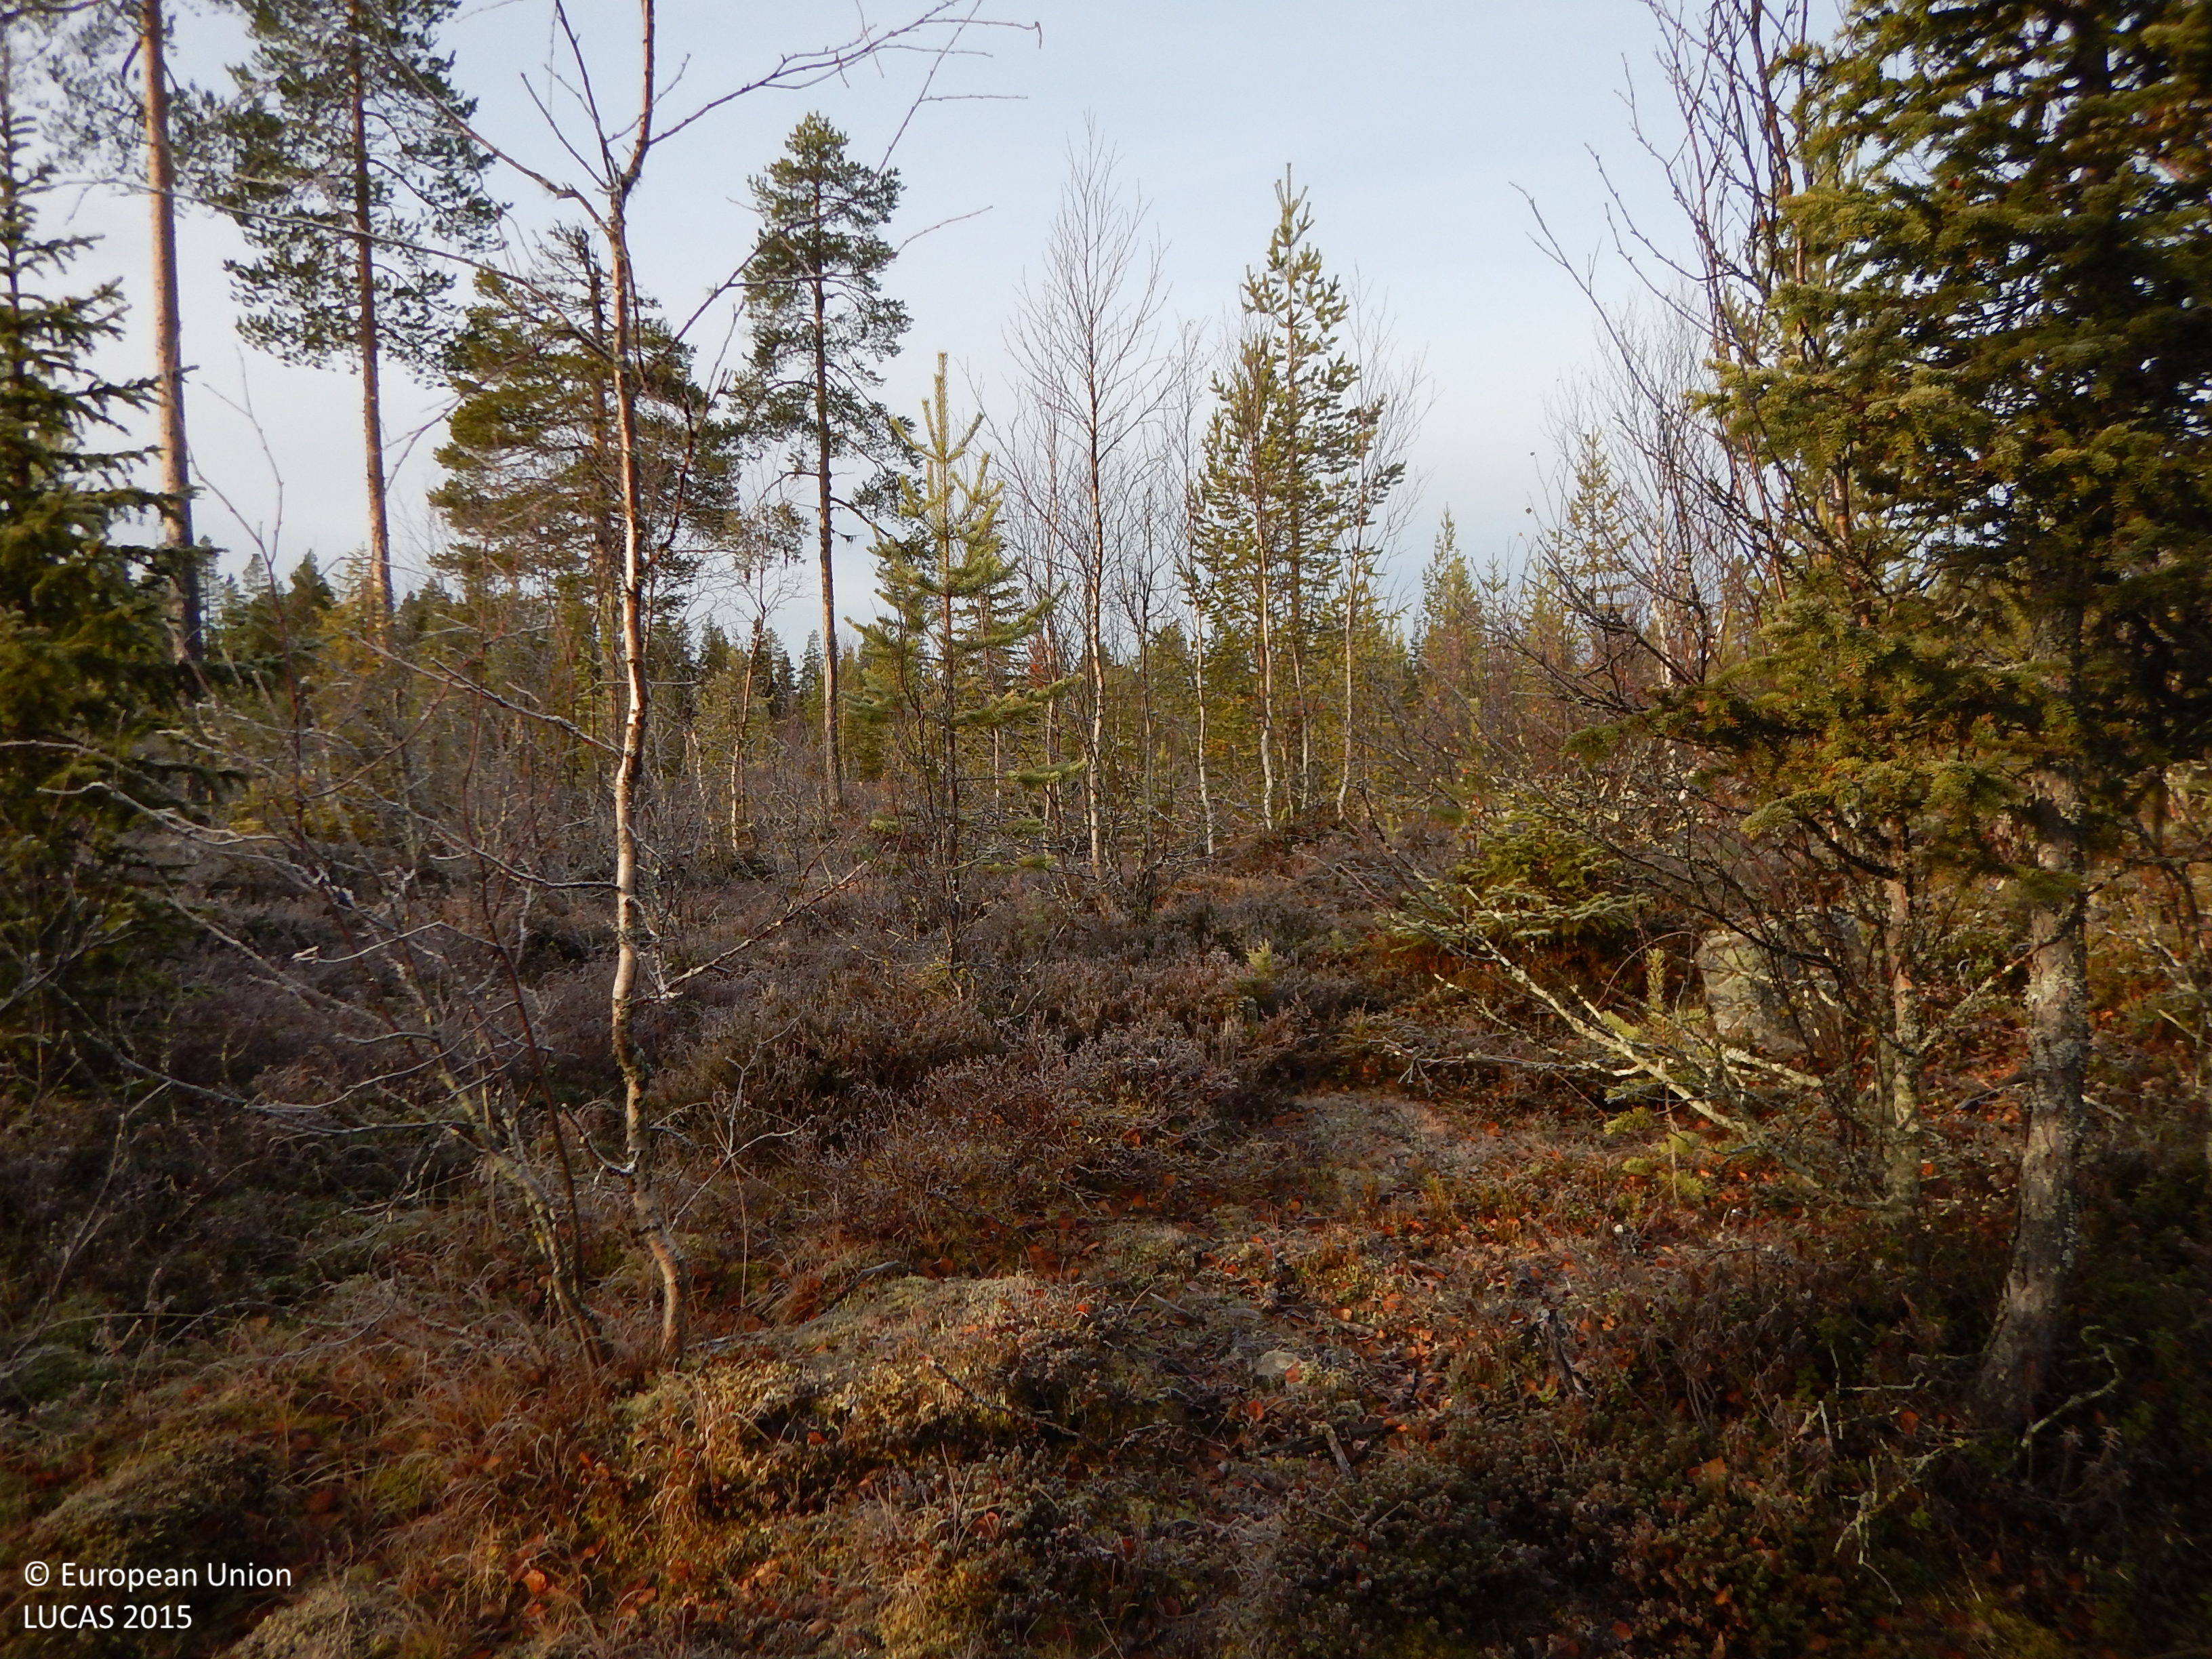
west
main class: Woodland
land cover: Other mixed woodland
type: boreal forest
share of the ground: 25 - 50 %
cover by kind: lichens and mosses 30 %, coniferous forest trees 25 %, broadleaved forest trees 20 %, shrubs 20 %, herbaceous plants 5 %
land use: Forestry
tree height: > 5 m
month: October
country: SE
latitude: 65.3710
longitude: 20.0952
